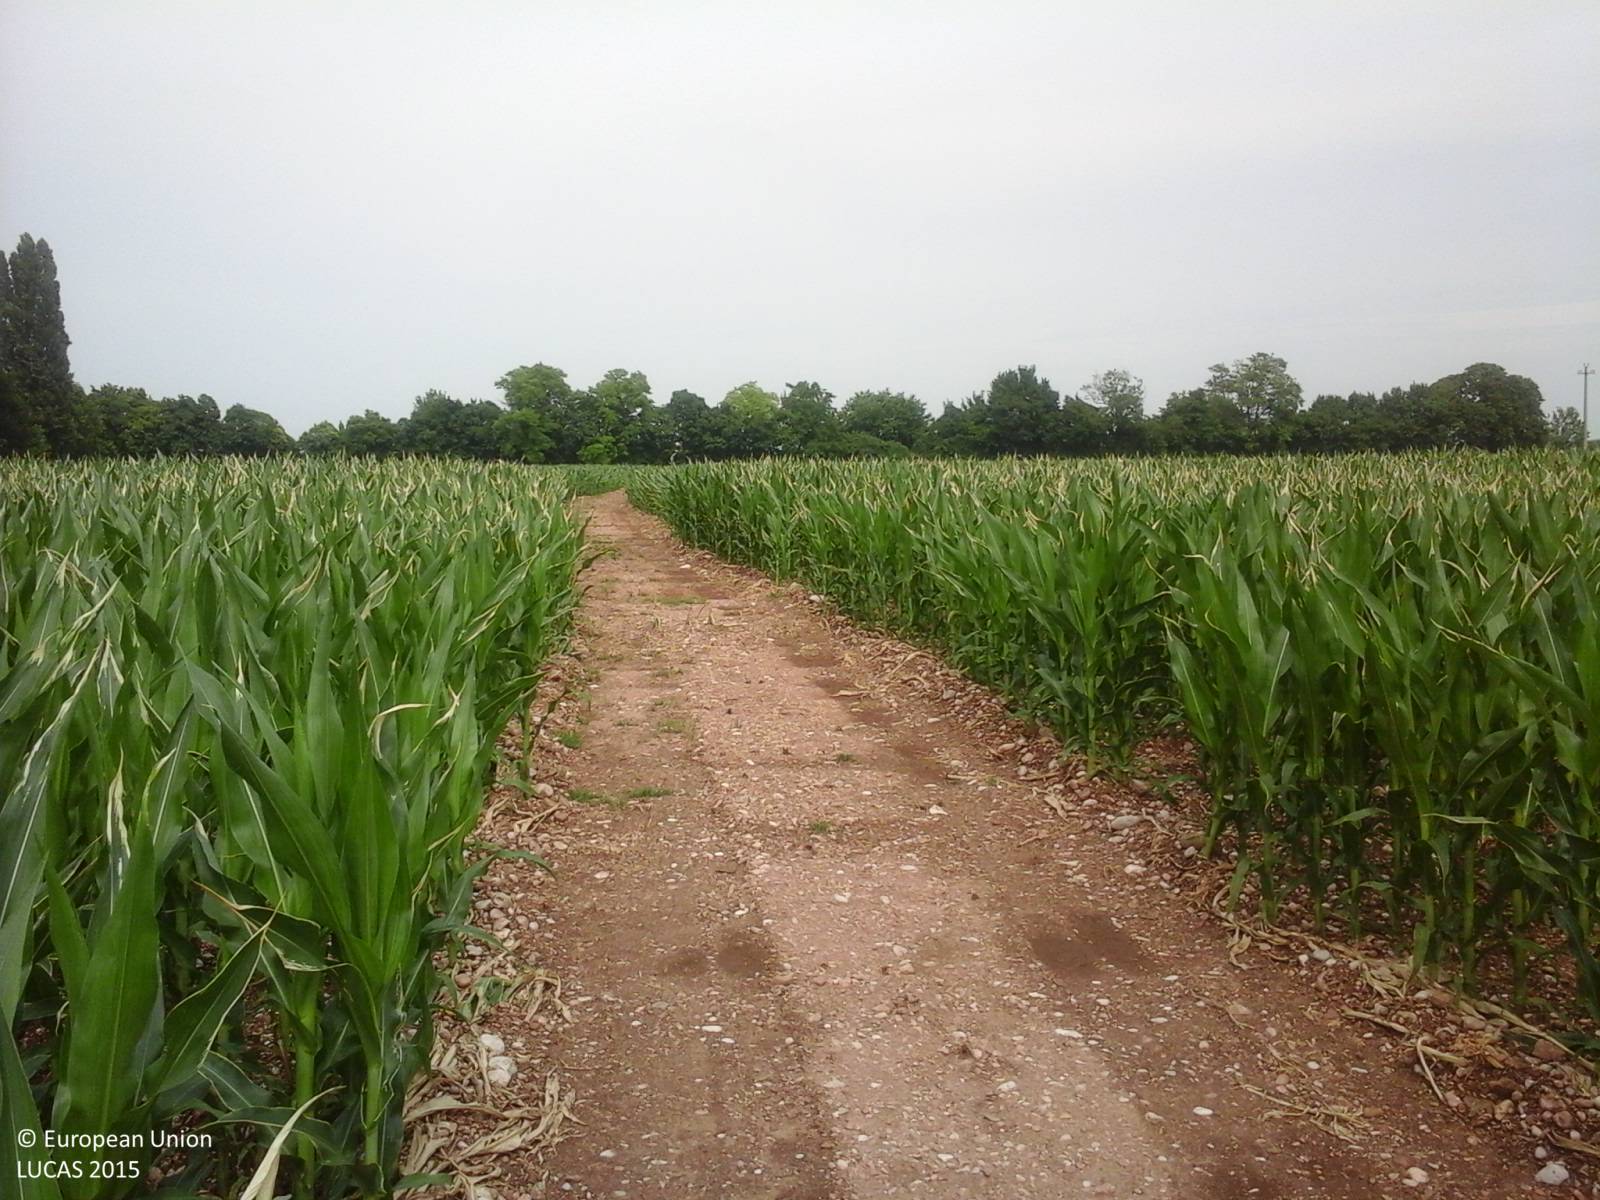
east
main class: Cropland
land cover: Maize
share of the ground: > 75 %
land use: Agriculture (excluding fallow land and kitchen gardens)
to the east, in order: Maize; Tracks; Maize; Tracks; Grass margins; Ditches and canals; Abandoned hedges; Grass margins; Paved roads, cycling and walking lanes; Grass margins; Lines of trees; Soya
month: June
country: IT
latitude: 46.0108
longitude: 12.6959
